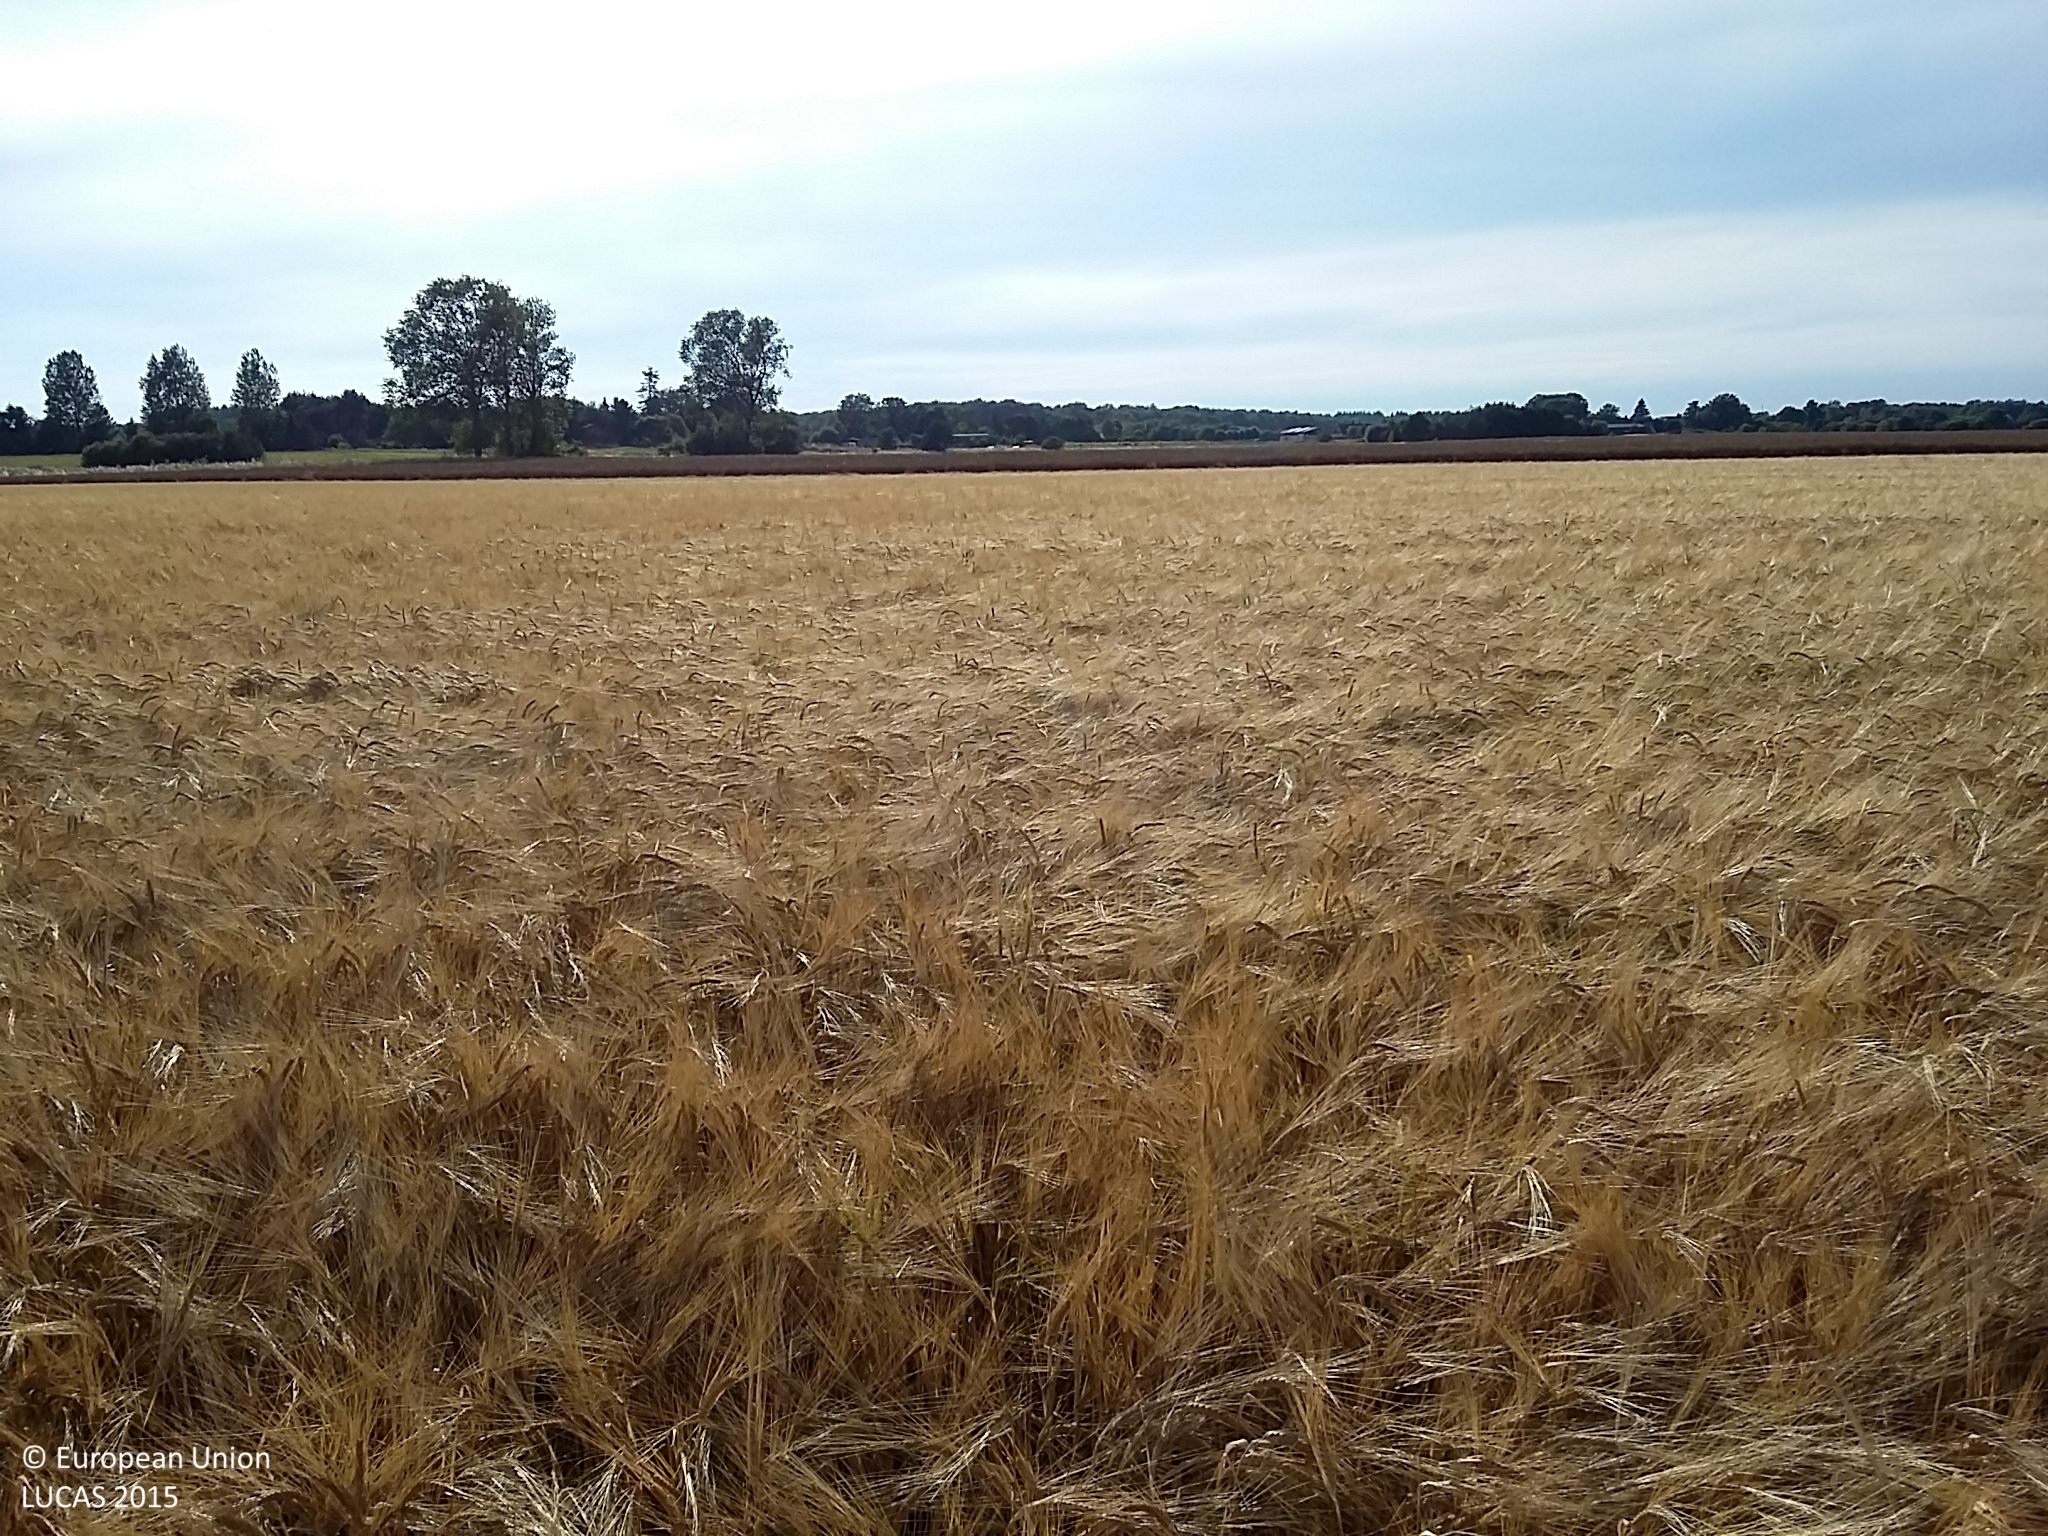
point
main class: Cropland
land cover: Barley
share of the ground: > 75 %
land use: Agriculture (excluding fallow land and kitchen gardens)
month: August
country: DK
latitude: 55.5242
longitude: 12.0417
